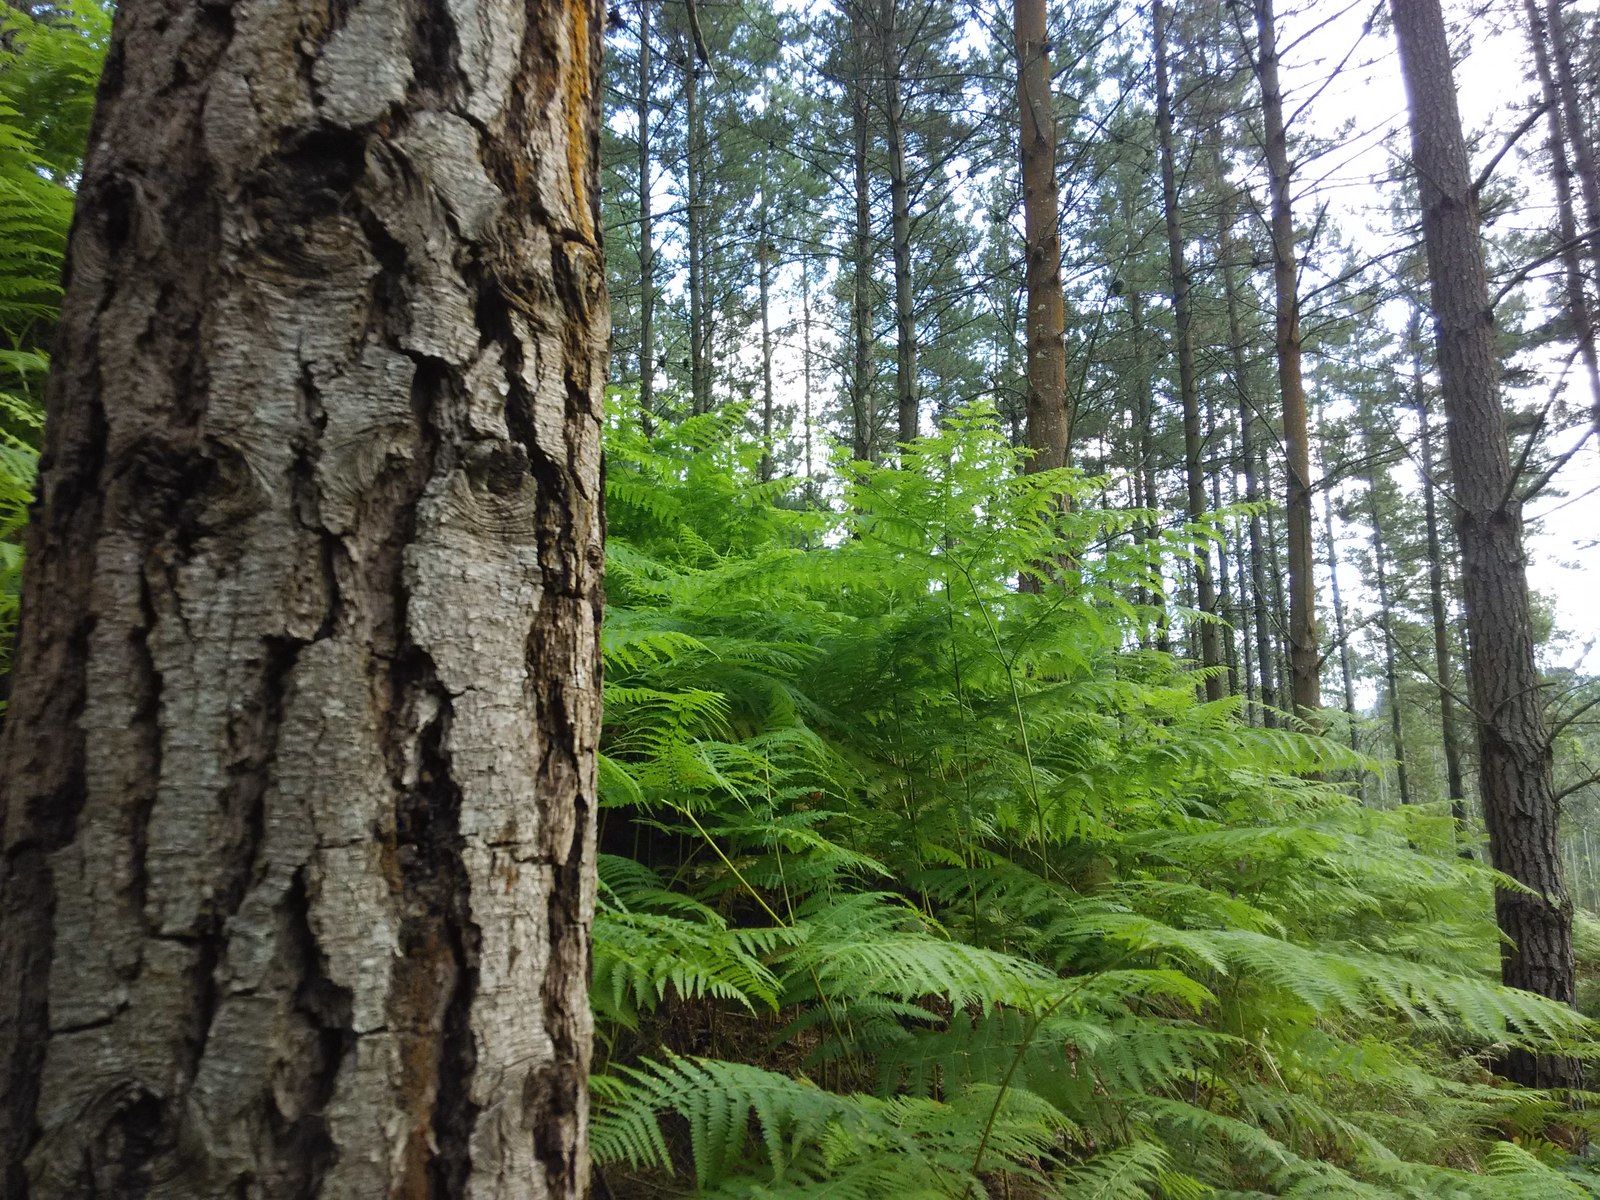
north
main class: Woodland
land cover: Pine dominated coniferous woodland
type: exotic forest
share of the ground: > 75 %
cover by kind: coniferous forest trees 100 %
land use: Forestry
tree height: > 5 m
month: June
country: ES
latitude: 43.3185
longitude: -2.4950
